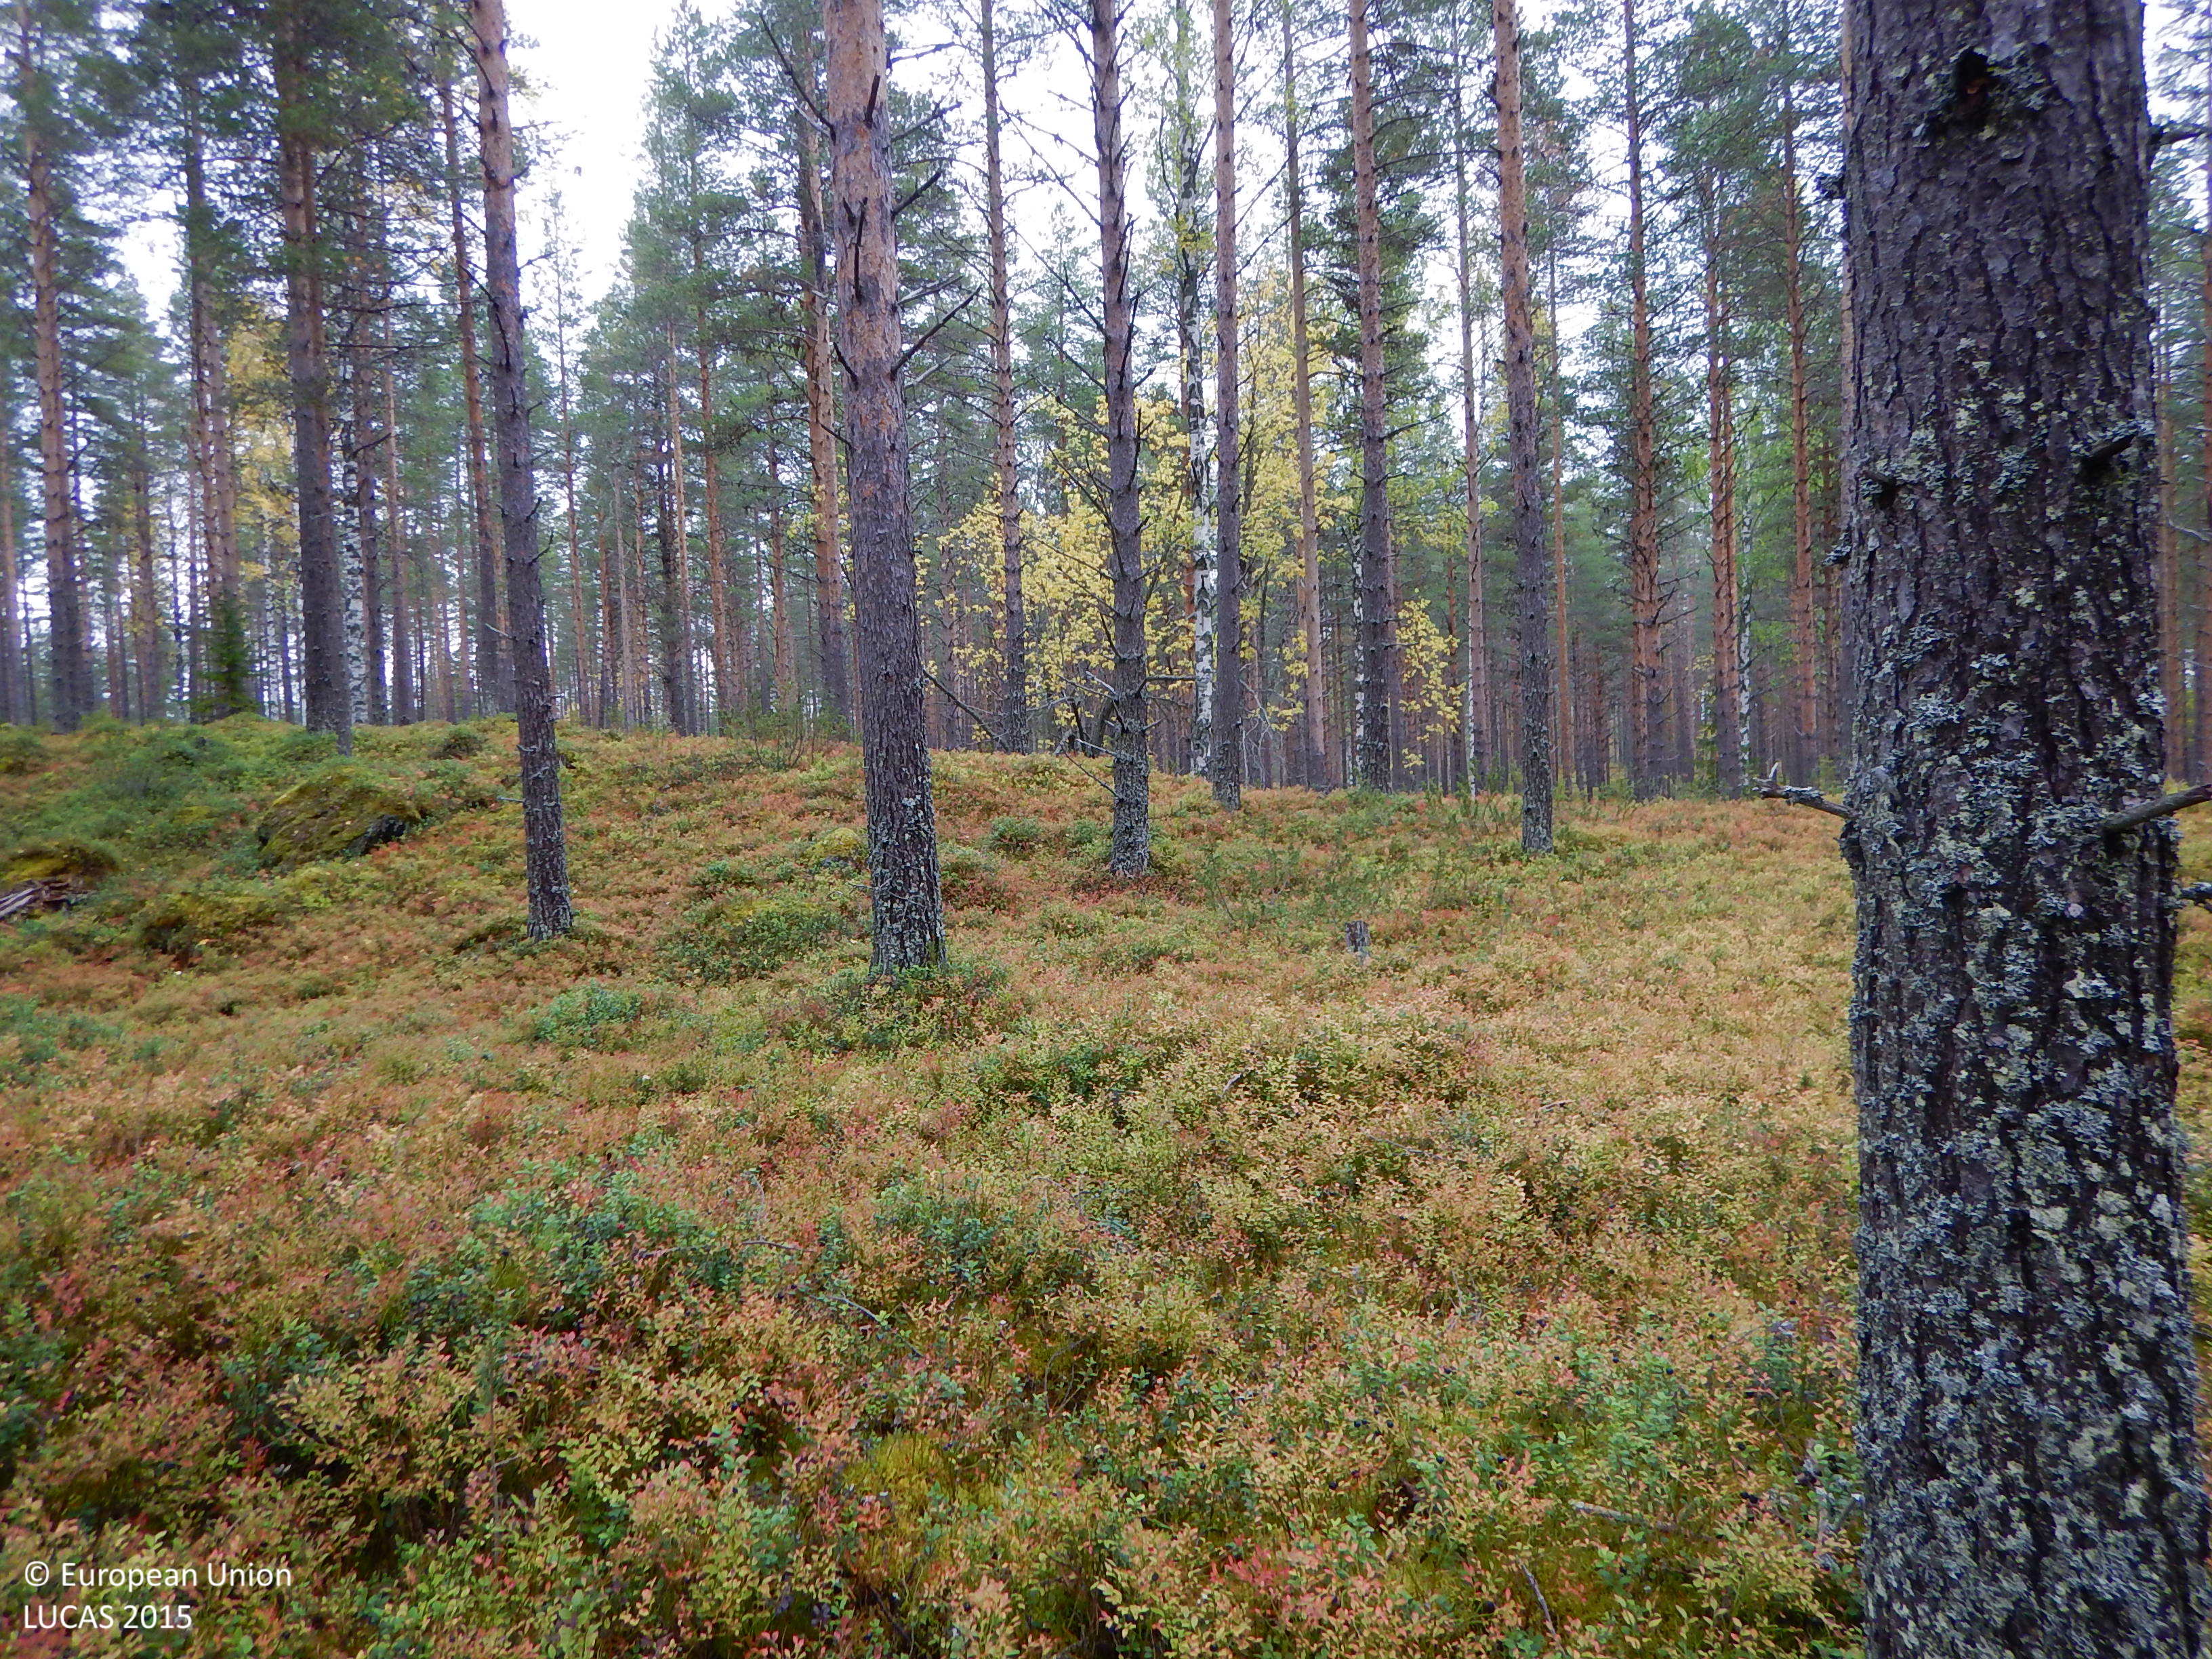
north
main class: Woodland
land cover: Pine dominated coniferous woodland
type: boreal forest
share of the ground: 50 - 75 %
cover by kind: coniferous forest trees 60 %, shrubs 20 %, lichens and mosses 15 %, broadleaved forest trees 5 %
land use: Forestry
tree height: > 5 m
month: September
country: SE
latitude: 65.1374
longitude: 19.1091
